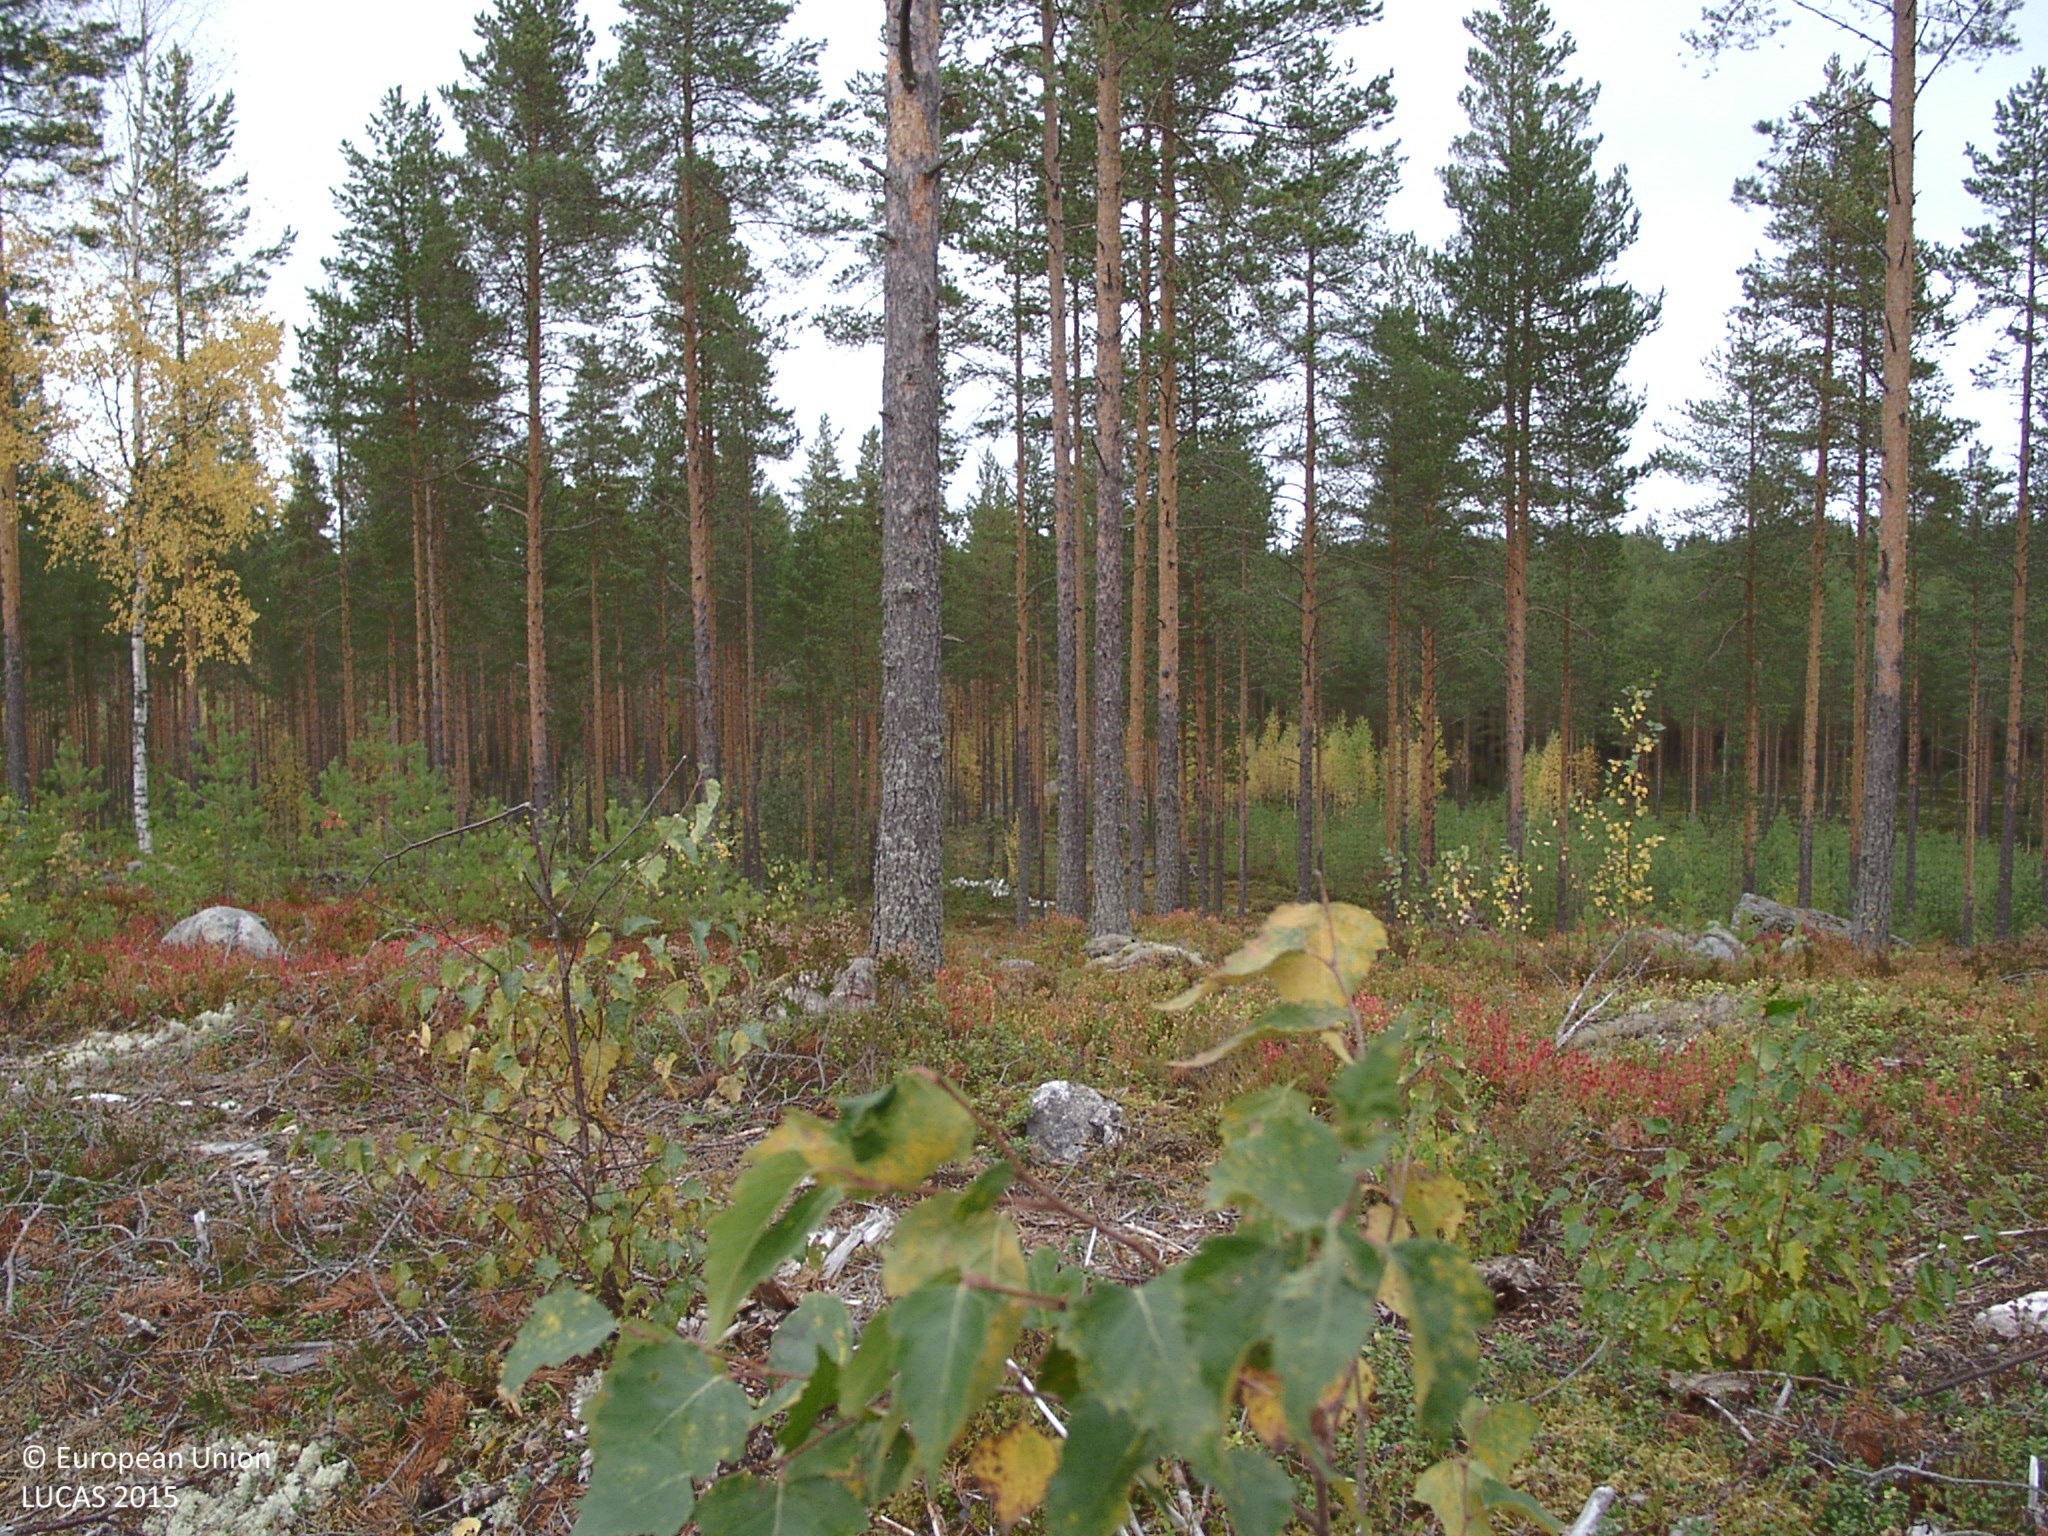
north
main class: Shrubland
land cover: Shrubland with sparse tree cover
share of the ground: 50 - 75 %
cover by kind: shrubs 60 %, lichens and mosses 30 %, coniferous forest trees 5 %
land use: Forestry
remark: Clear cut
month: September
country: FI
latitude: 62.6019
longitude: 25.4393
